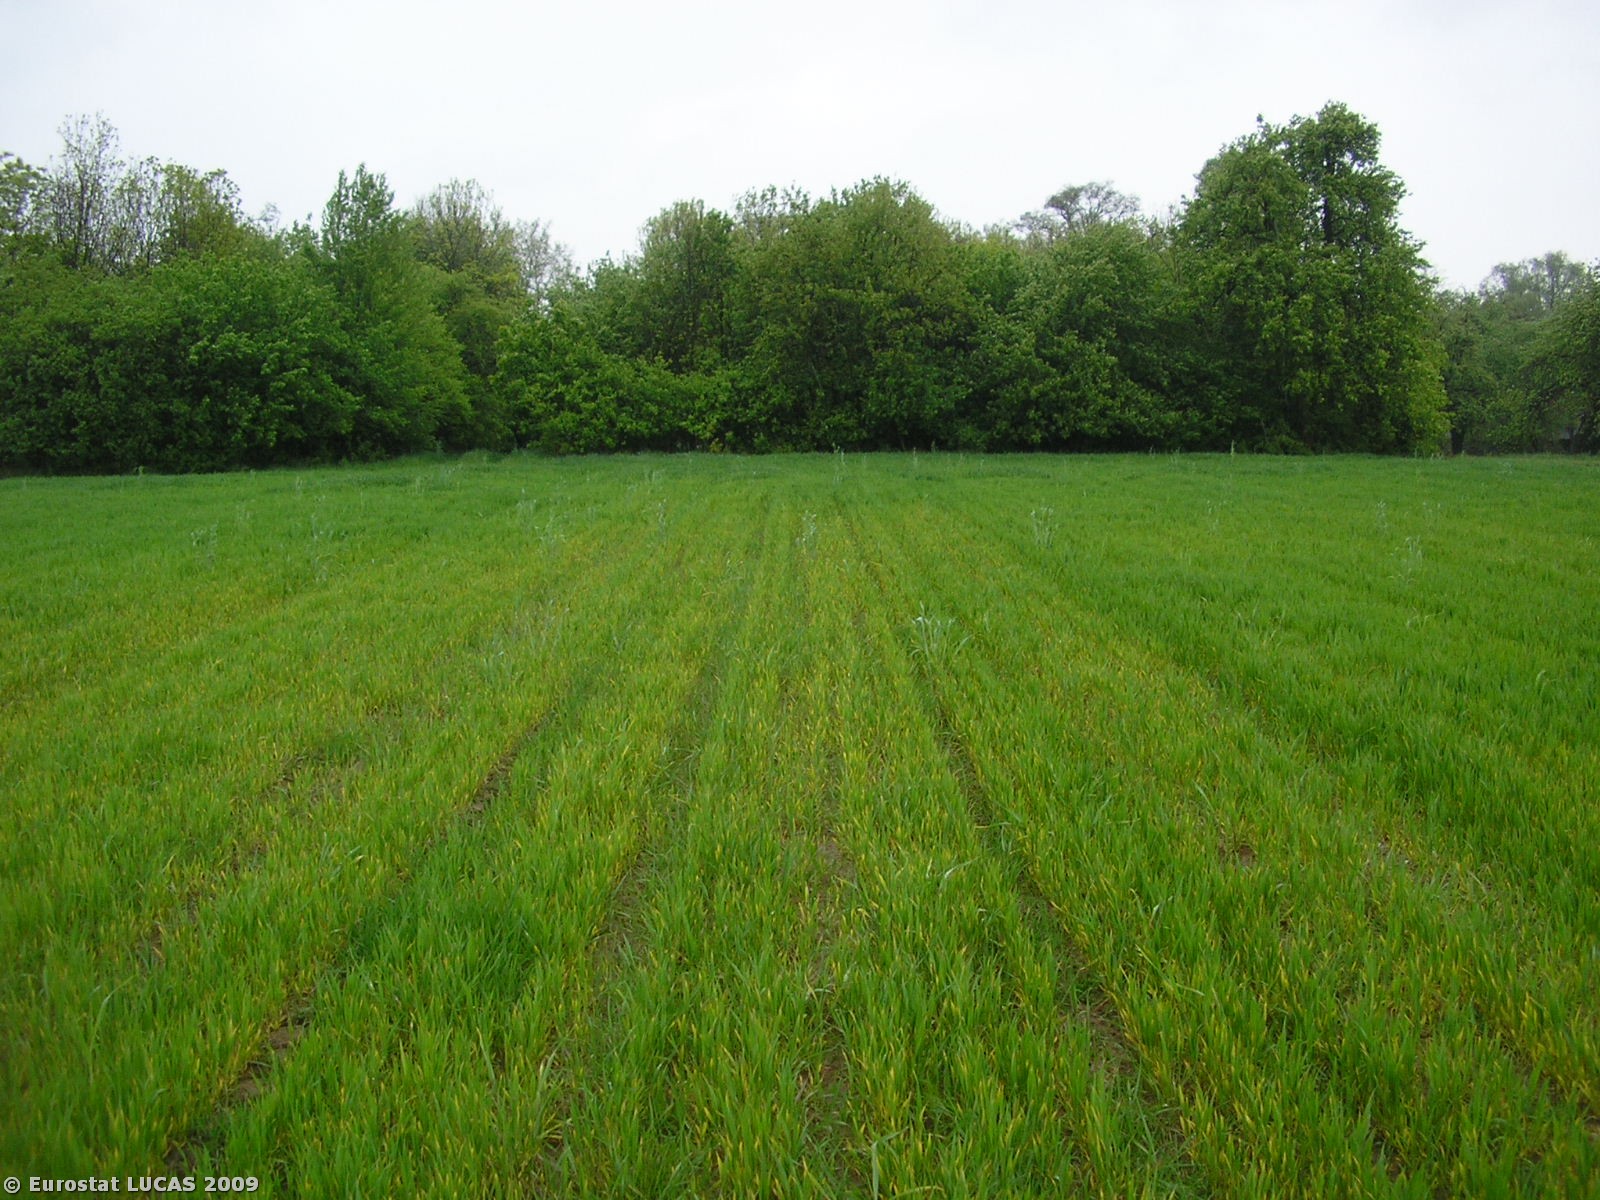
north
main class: Cropland
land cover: Common wheat
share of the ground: > 75 %
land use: Agriculture (excluding fallow land and kitchen gardens)
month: June
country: PL
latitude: 52.4546
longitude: 20.2925
